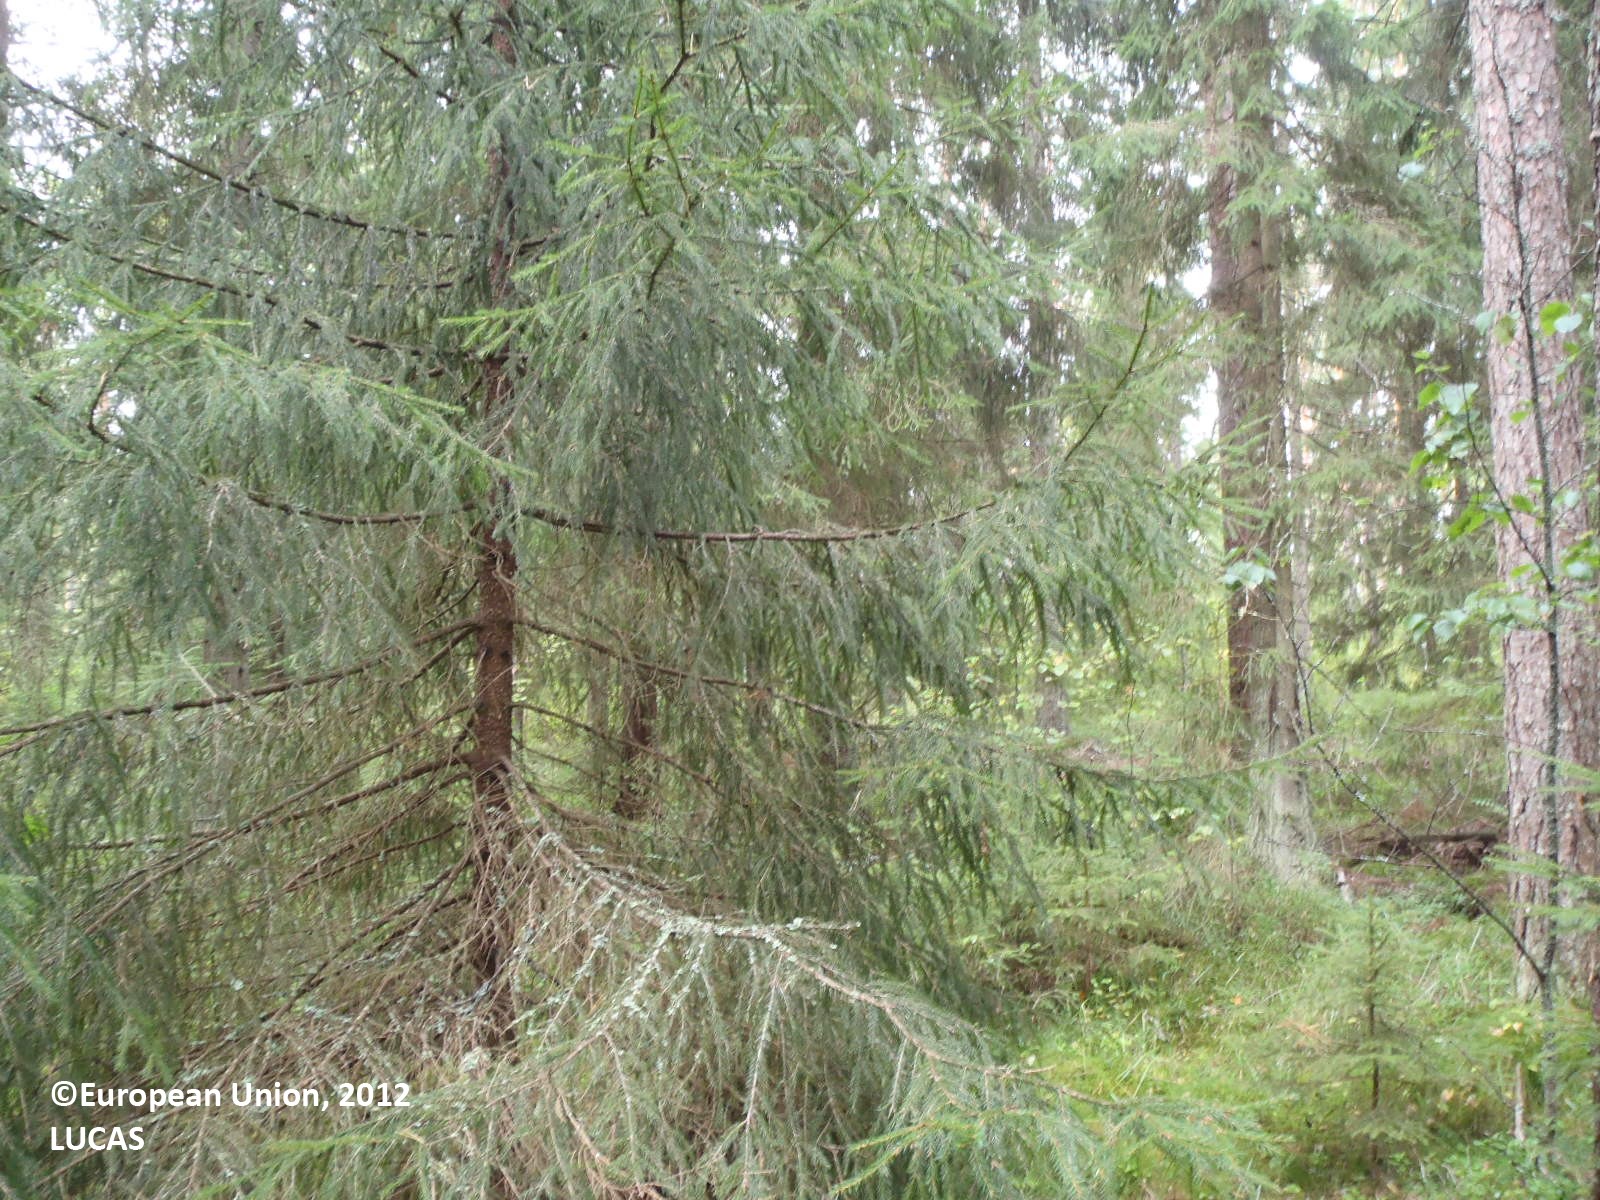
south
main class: Woodland
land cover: Spruce dominated coniferous woodland
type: boreal forest
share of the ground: > 75 %
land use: Forestry
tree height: > 5 m
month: August
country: FI
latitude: 60.6604
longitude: 22.5292
